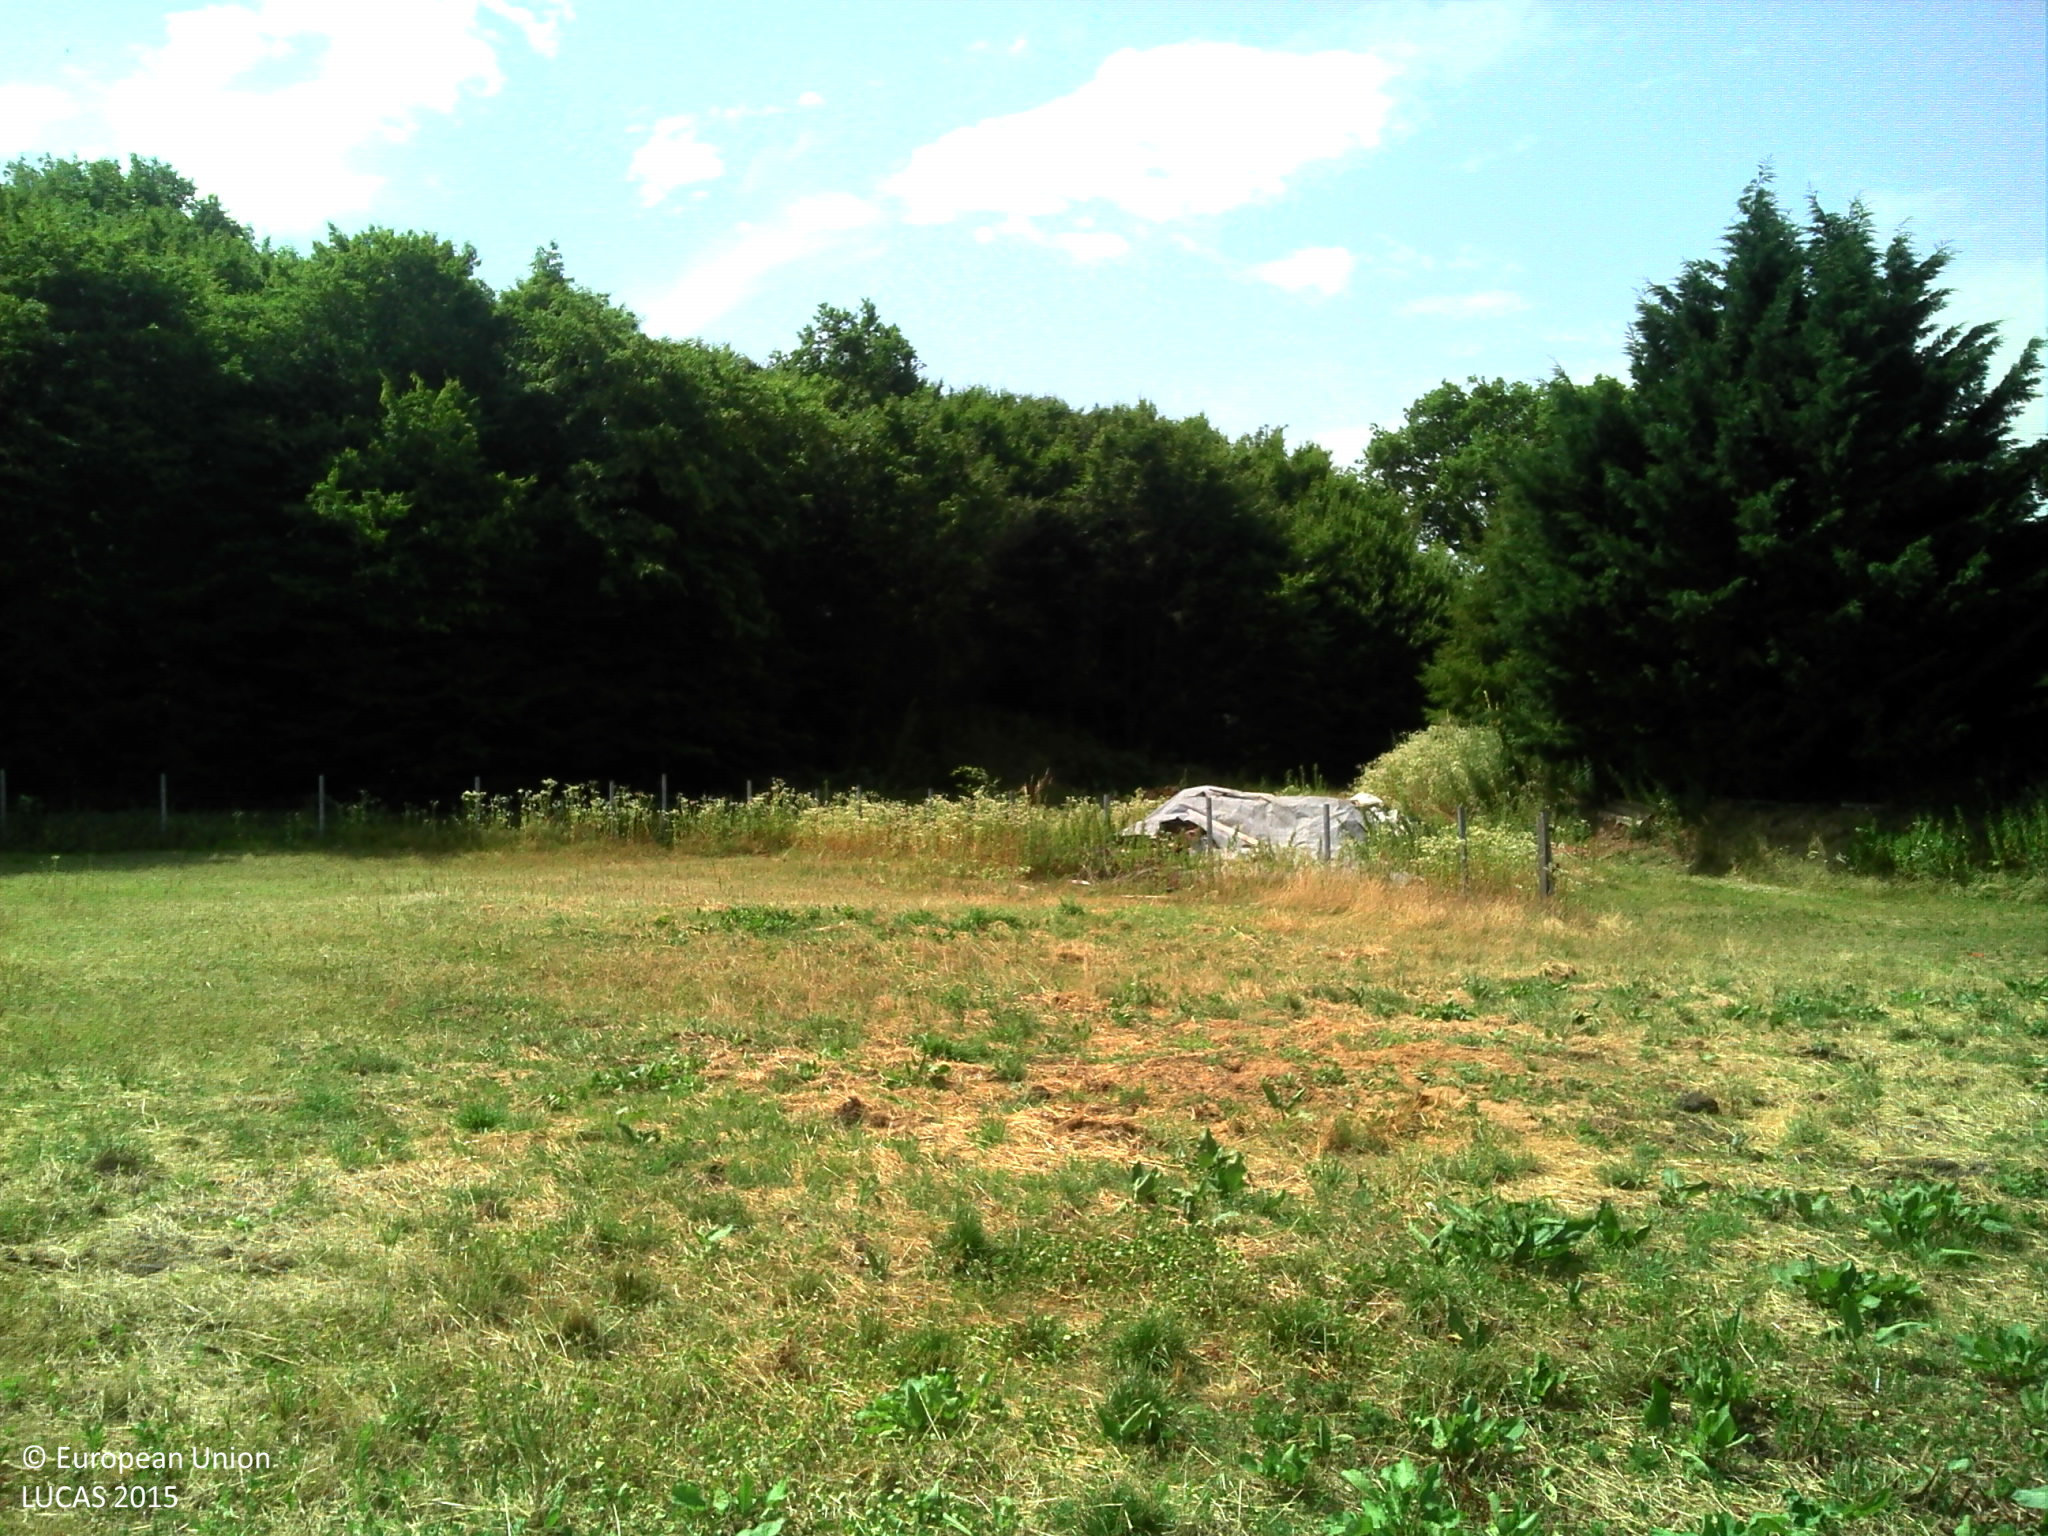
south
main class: Grassland
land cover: Grassland without tree/shrub cover
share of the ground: > 75 %
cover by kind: herbaceous plants 100 %
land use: Agriculture (excluding fallow land and kitchen gardens)
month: July
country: FR
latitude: 45.6927
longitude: 5.3941
